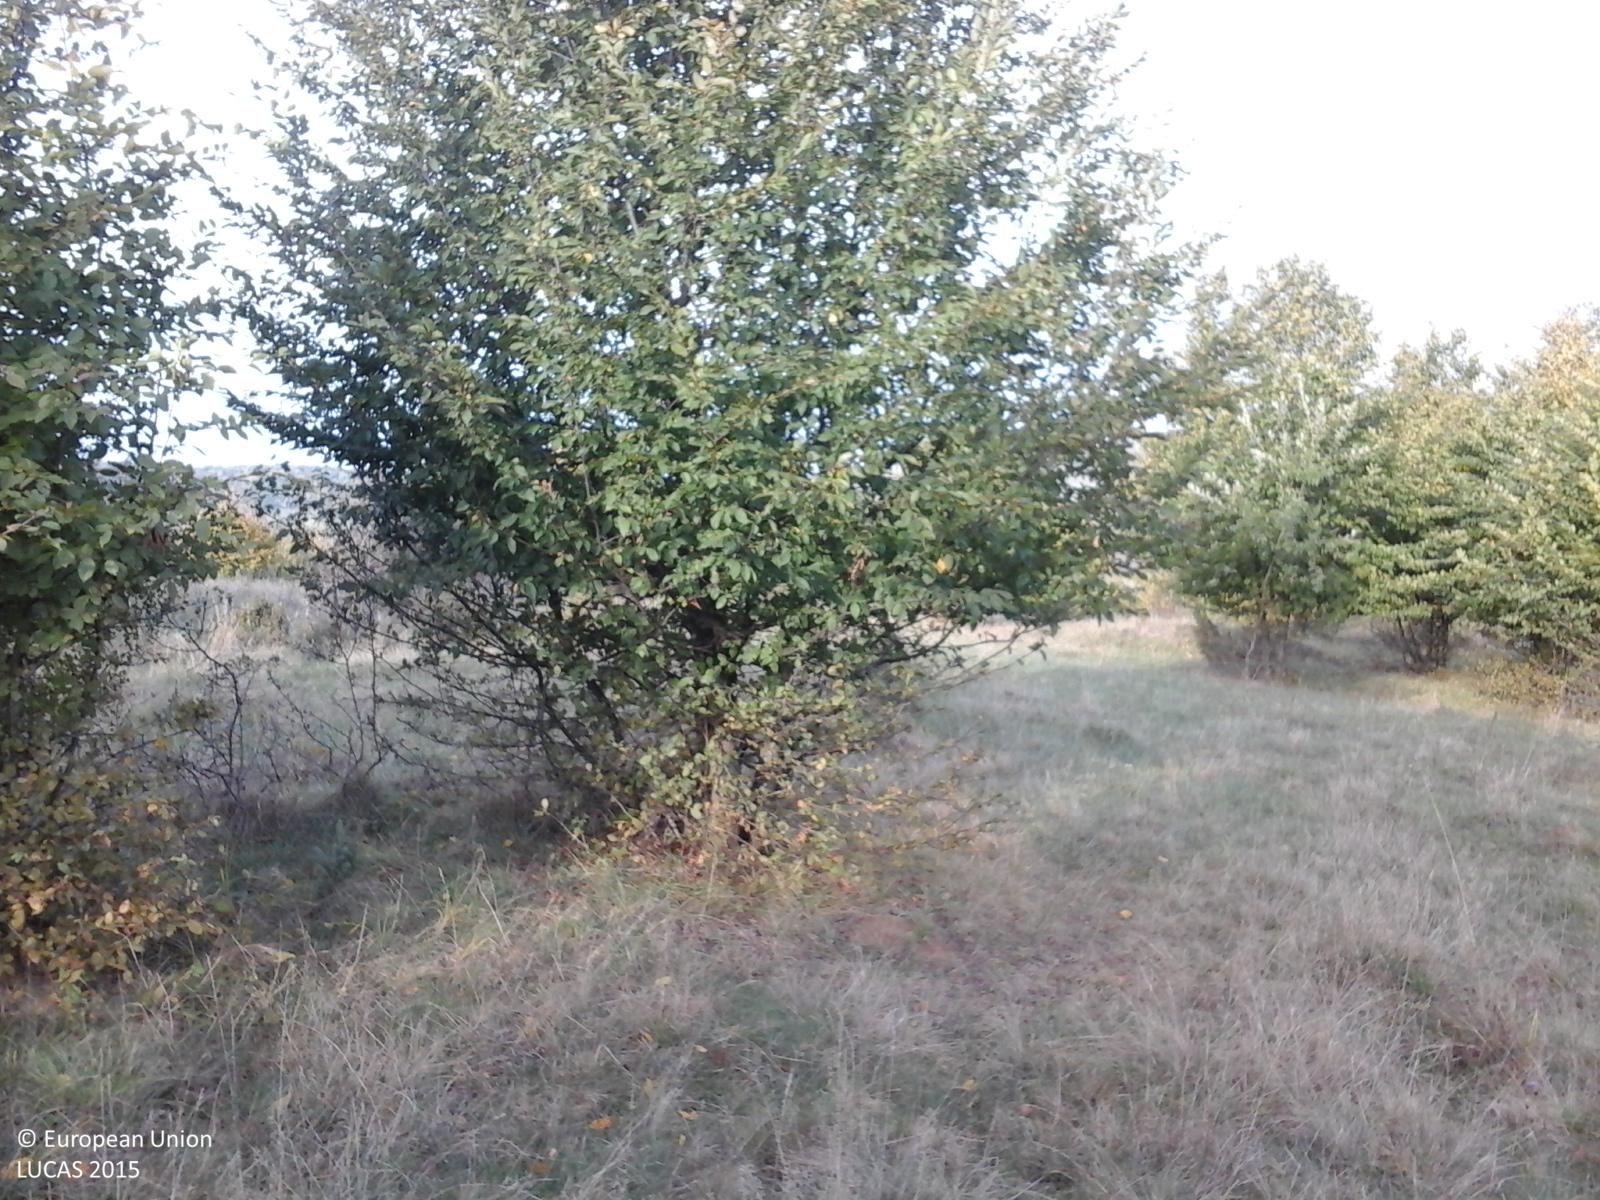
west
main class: Grassland
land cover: Grassland with sparse tree/shrub cover
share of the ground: > 75 %
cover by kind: herbaceous plants 85 %, shrubs 10 %, broadleaved forest trees 5 %
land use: Fallow land
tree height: < 5 m
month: October
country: RO
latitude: 46.2020
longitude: 25.2507
